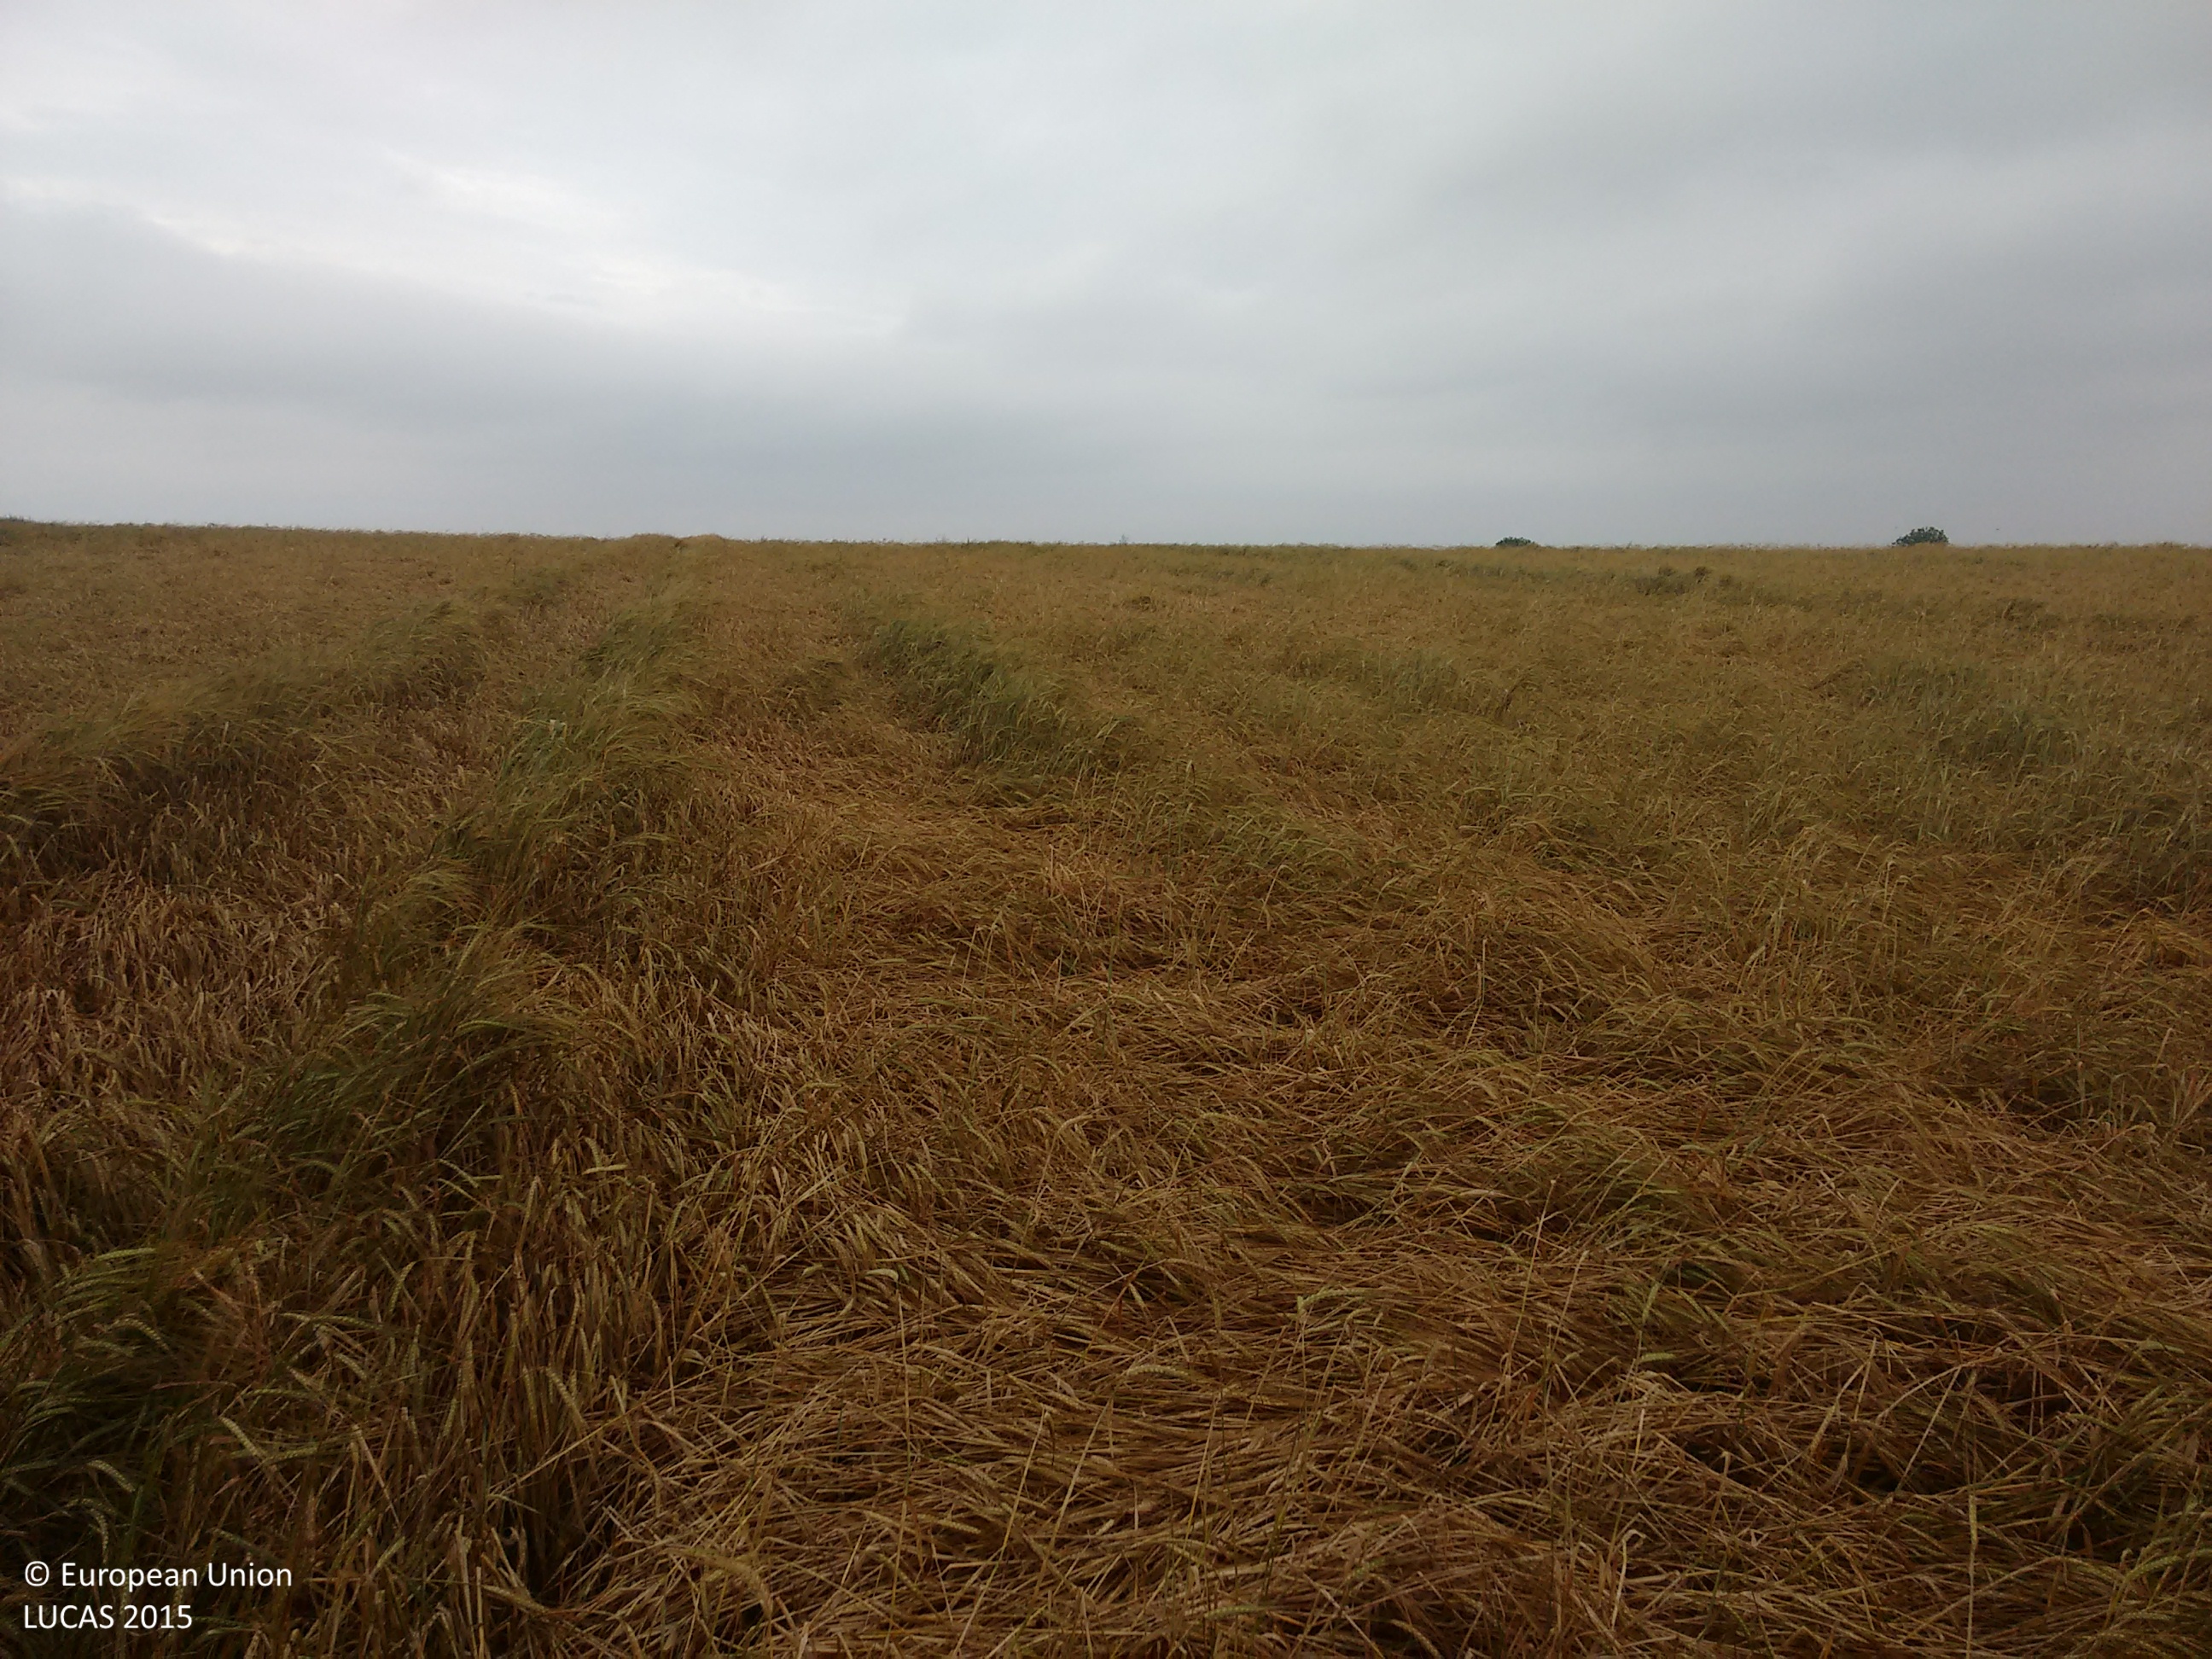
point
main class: Cropland
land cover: Barley
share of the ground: > 75 %
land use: Agriculture (excluding fallow land and kitchen gardens)
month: August
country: GB
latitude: 50.4835
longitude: -4.2919
